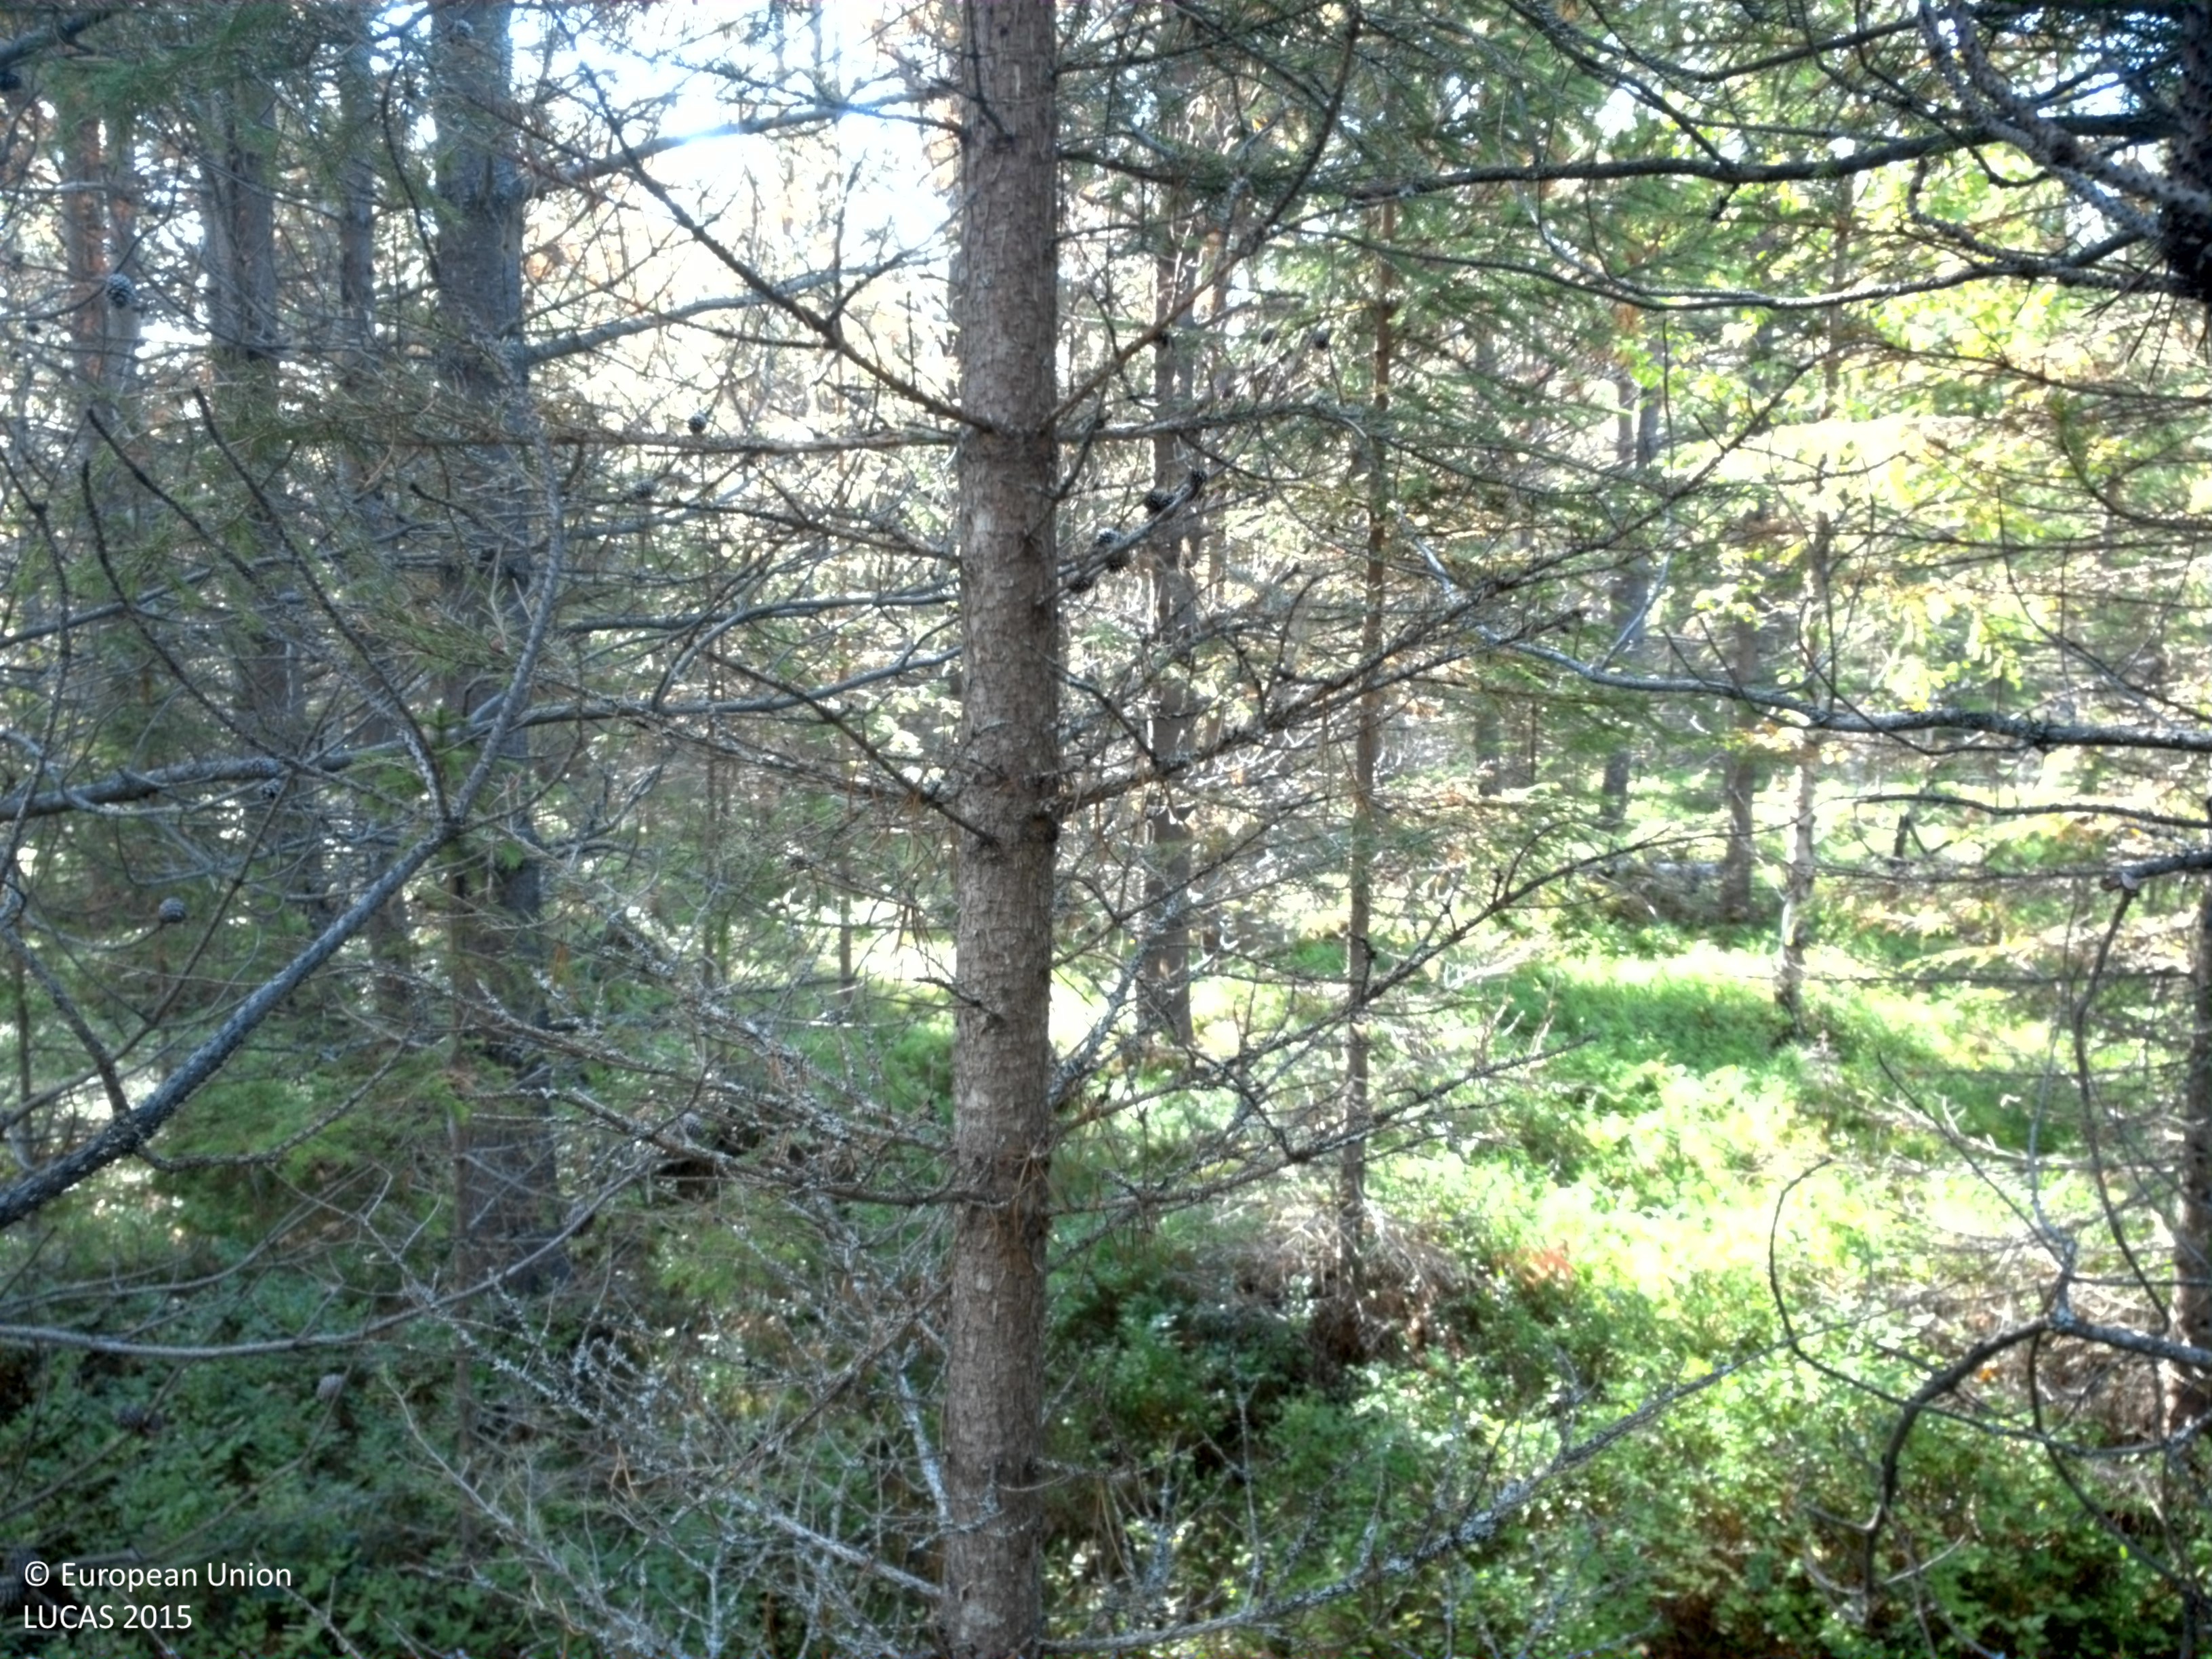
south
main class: Woodland
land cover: Pine dominated coniferous woodland
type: exotic forest
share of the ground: 50 - 75 %
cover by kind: coniferous forest trees 55 %, shrubs 30 %, broadleaved forest trees 5 %, herbaceous plants 5 %, lichens and mosses 5 %
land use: Forestry
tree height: > 5 m
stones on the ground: < 10 %
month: September
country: SE
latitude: 65.1212
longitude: 16.8442
